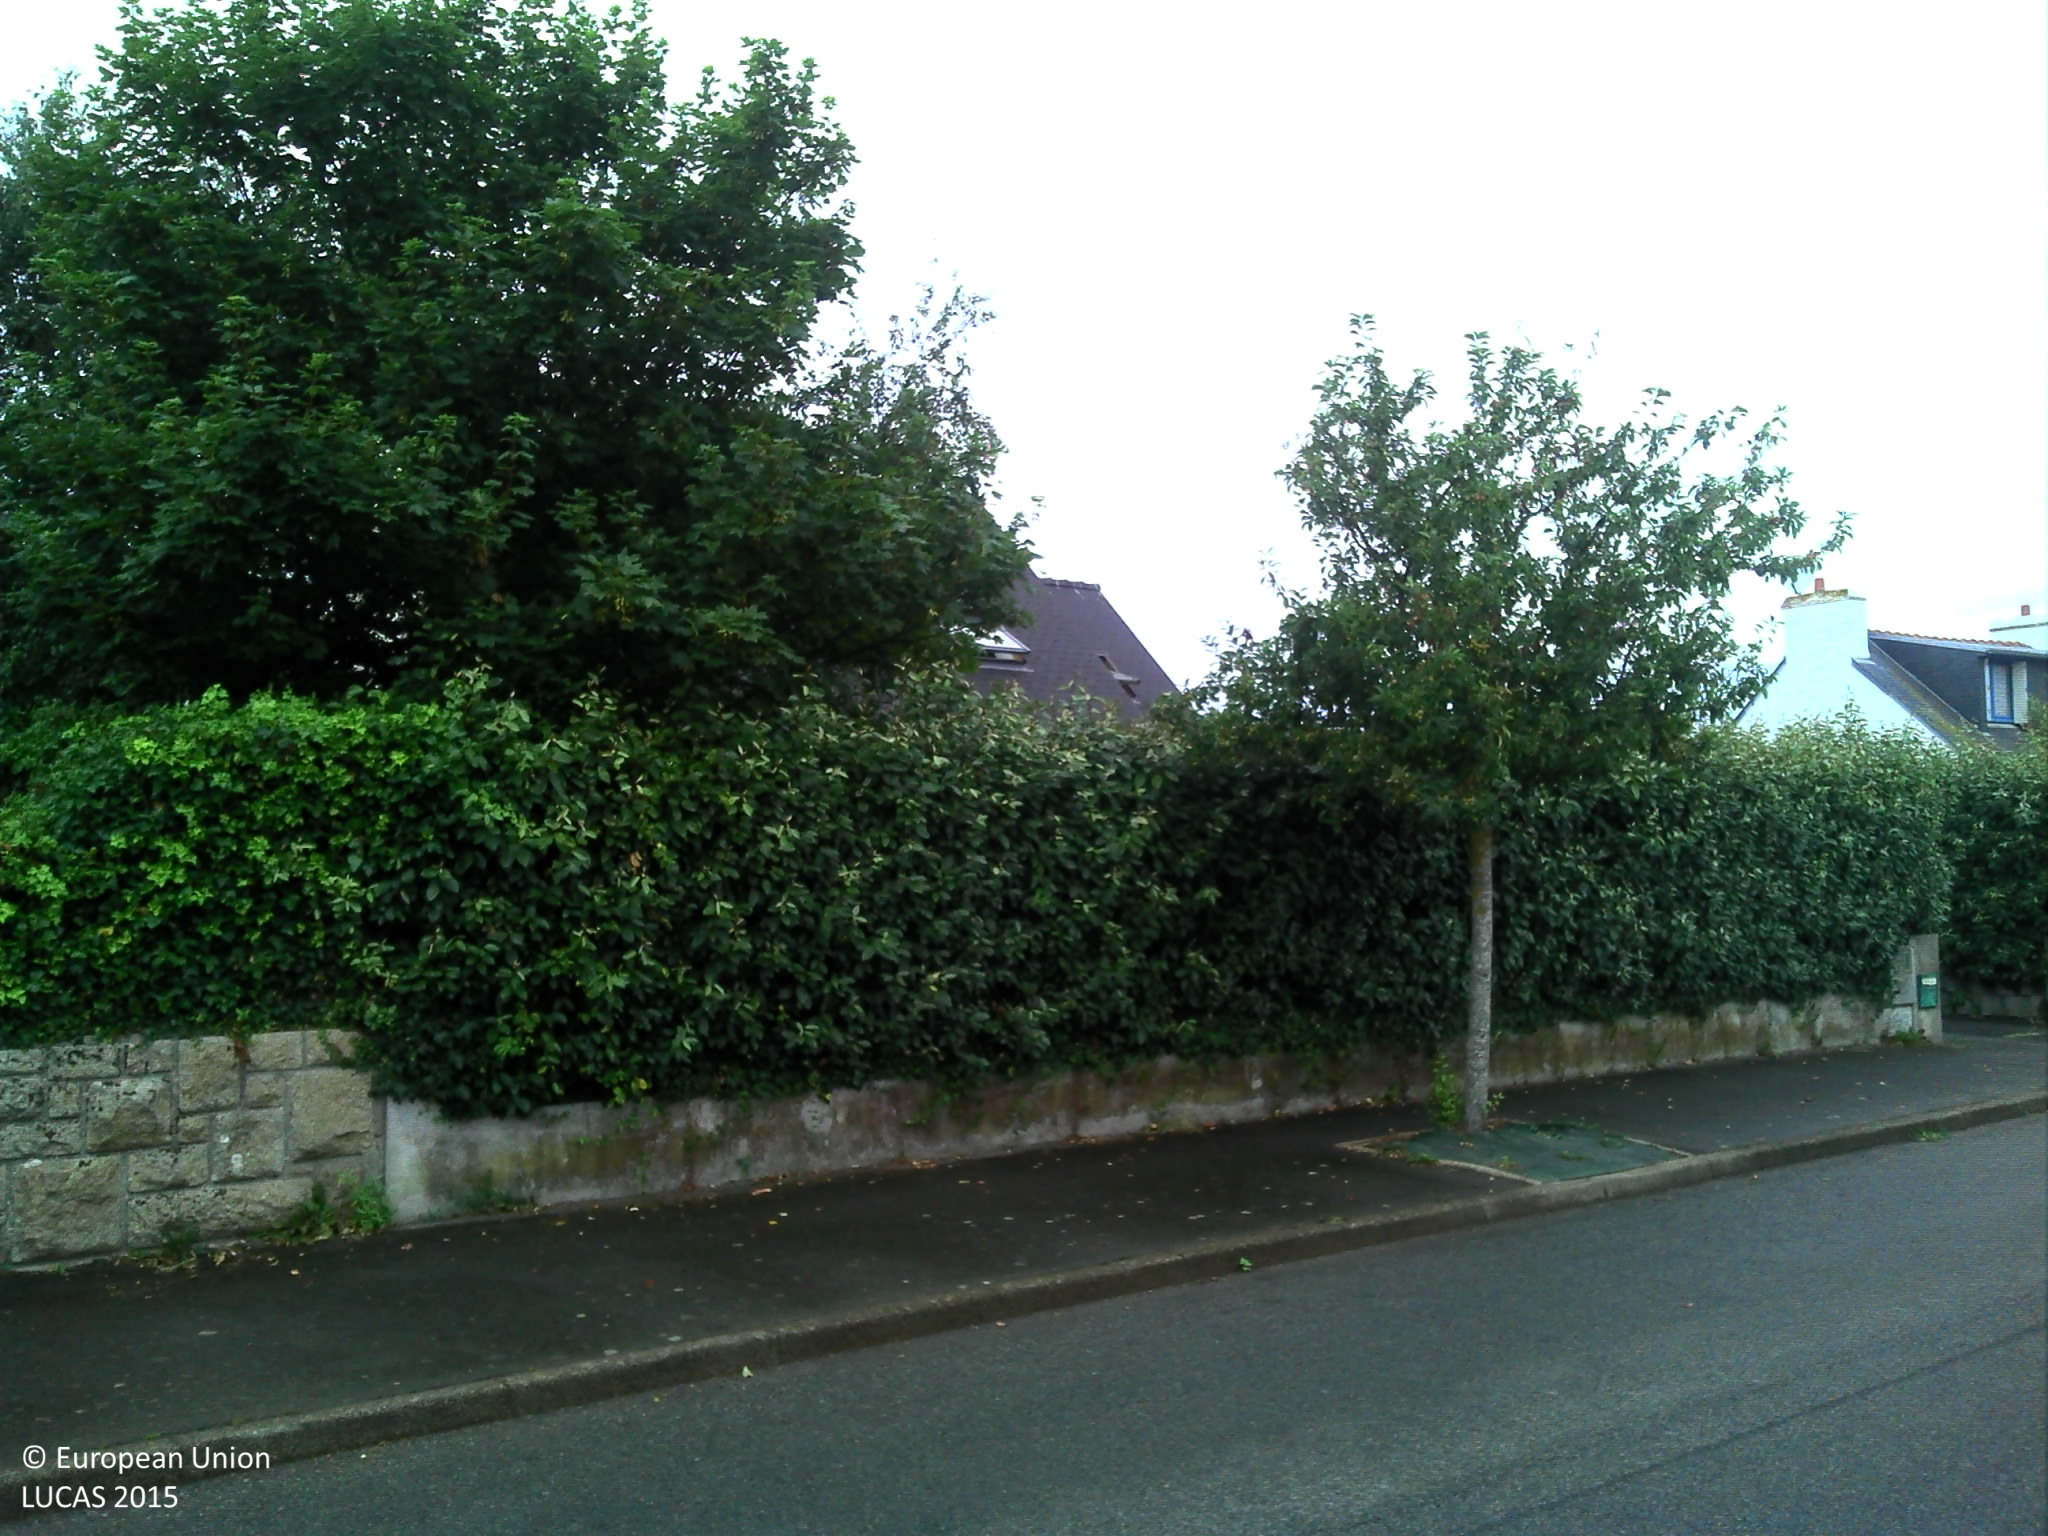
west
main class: Grassland
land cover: Grassland without tree/shrub cover
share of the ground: > 75 %
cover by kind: herbaceous plants 100 %
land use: Residential
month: July
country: FR
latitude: 47.7059
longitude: -3.4411
